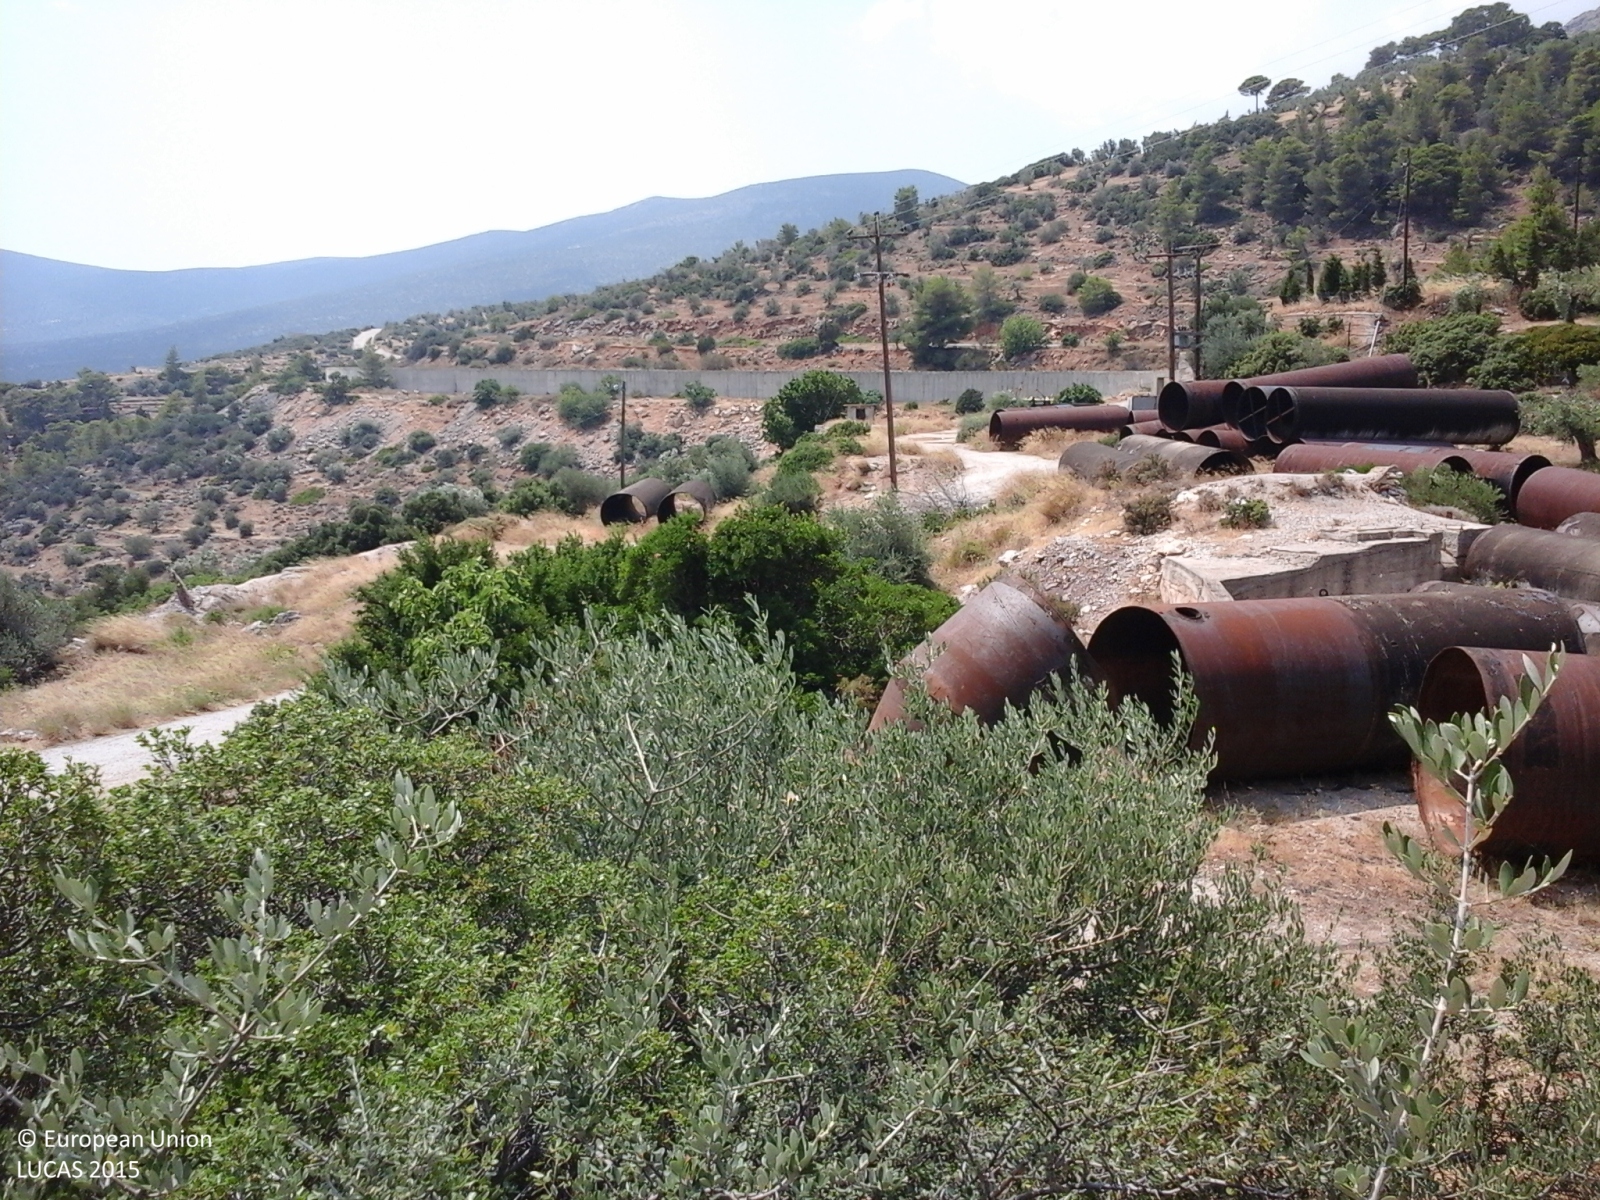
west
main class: Shrubland
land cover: Shrubland with sparse tree cover
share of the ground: 50 - 75 %
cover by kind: shrubs 60 %, unconsolidated bare surface 20 %, herbaceous plants 15 %, coniferous forest trees 5 %
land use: Agriculture (excluding fallow land and kitchen gardens)
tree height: < 5 m
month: July
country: GR
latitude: 38.2580
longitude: 22.9016
